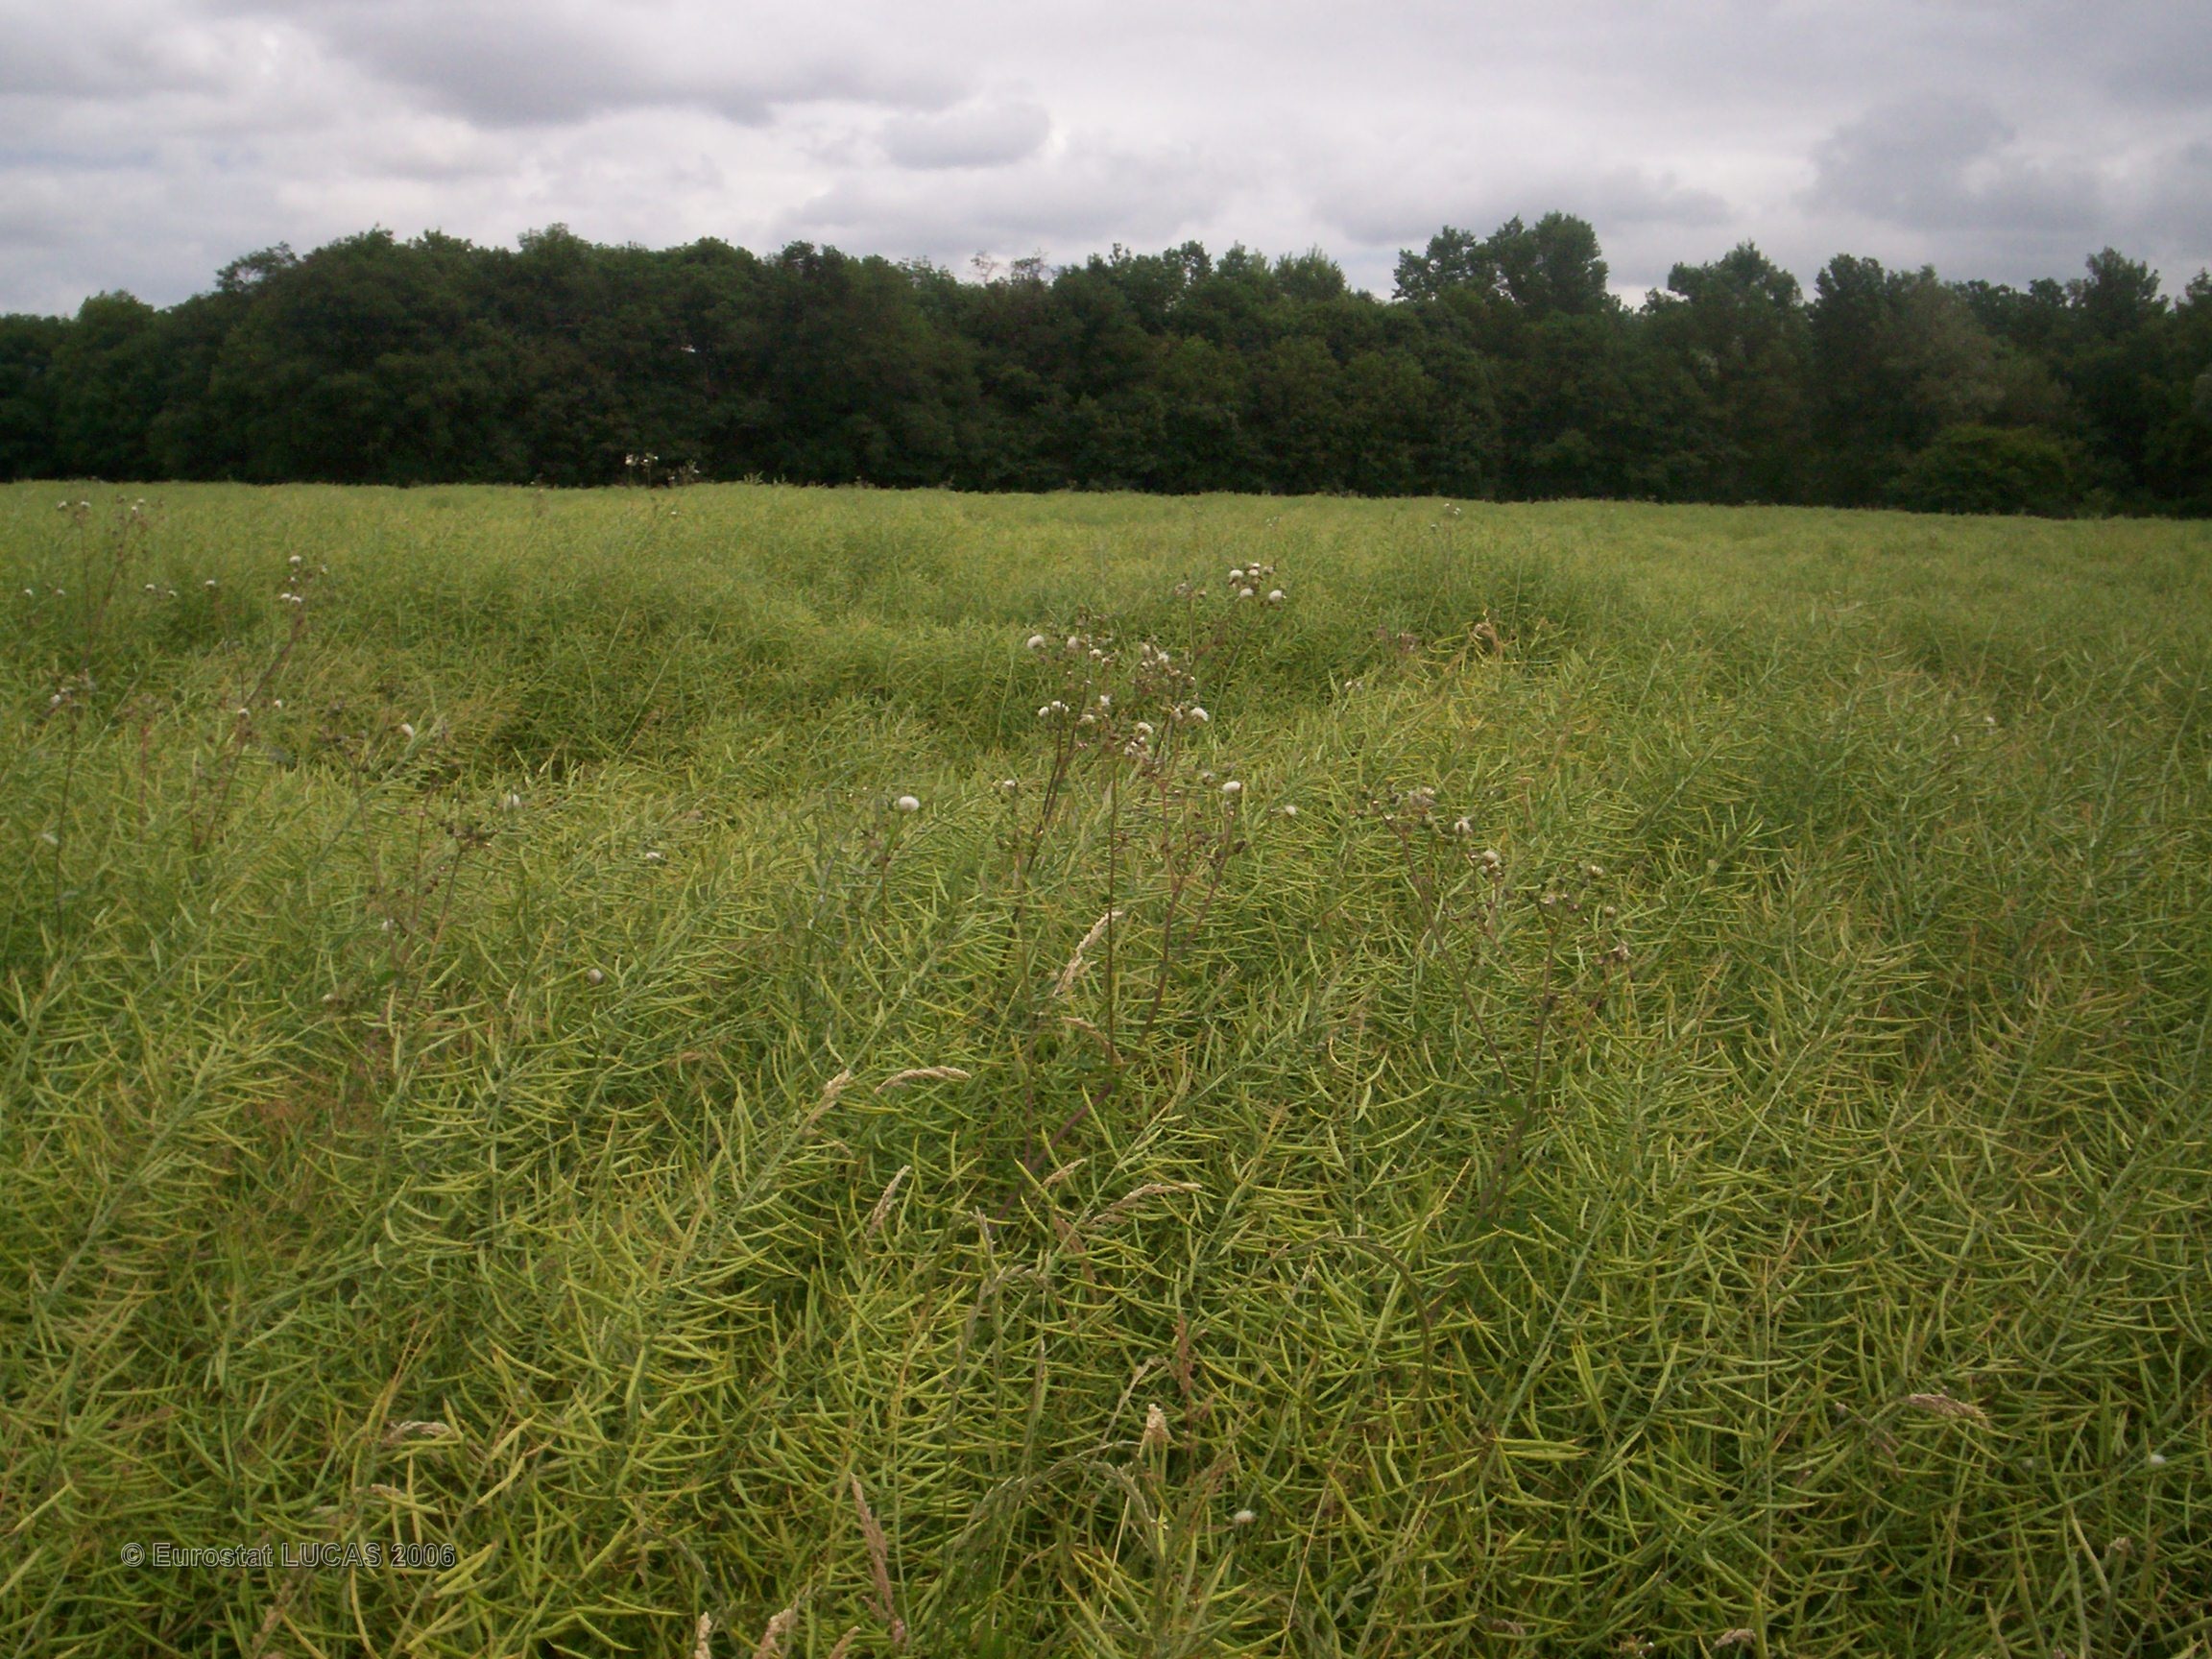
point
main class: Cropland
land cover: Rape and turnip rape
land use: Agriculture (excluding fallow land and kitchen gardens)
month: May
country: FR
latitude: 43.6611
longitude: -0.2386
